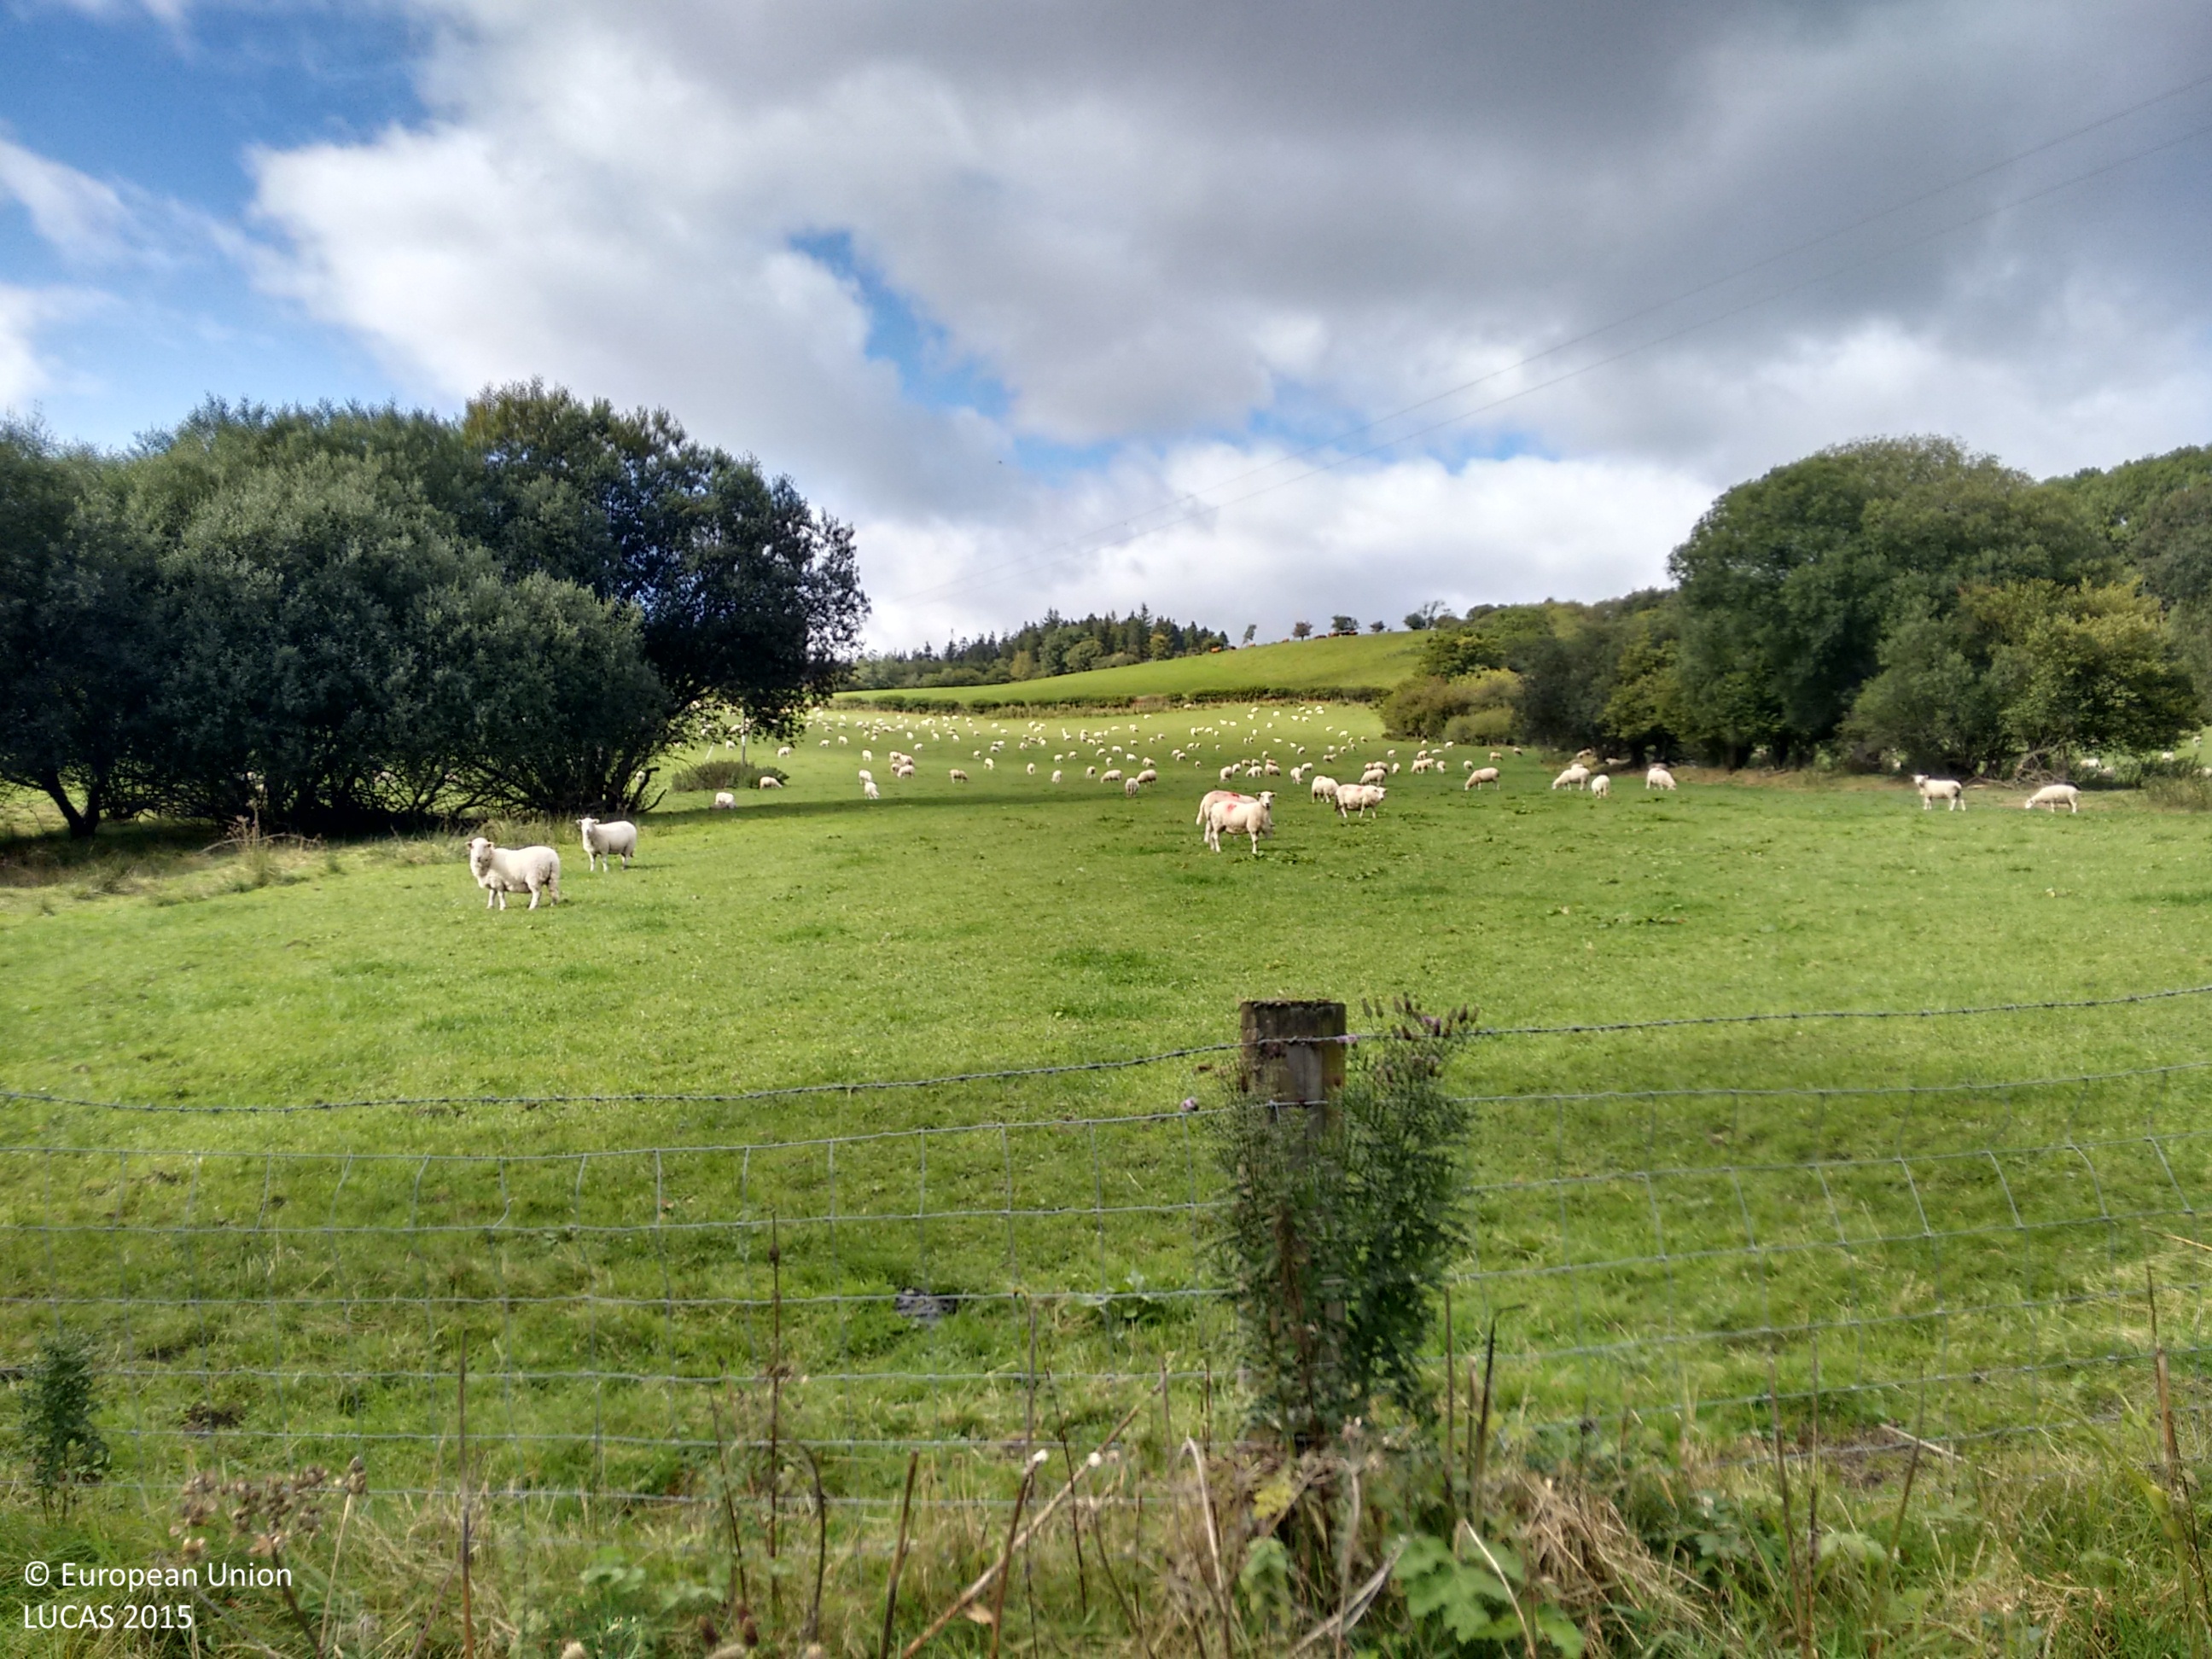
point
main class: Grassland
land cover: Grassland without tree/shrub cover
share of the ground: > 75 %
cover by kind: herbaceous plants 100 %
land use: Agriculture (excluding fallow land and kitchen gardens)
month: September
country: GB
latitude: 53.0710
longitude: -3.4104
